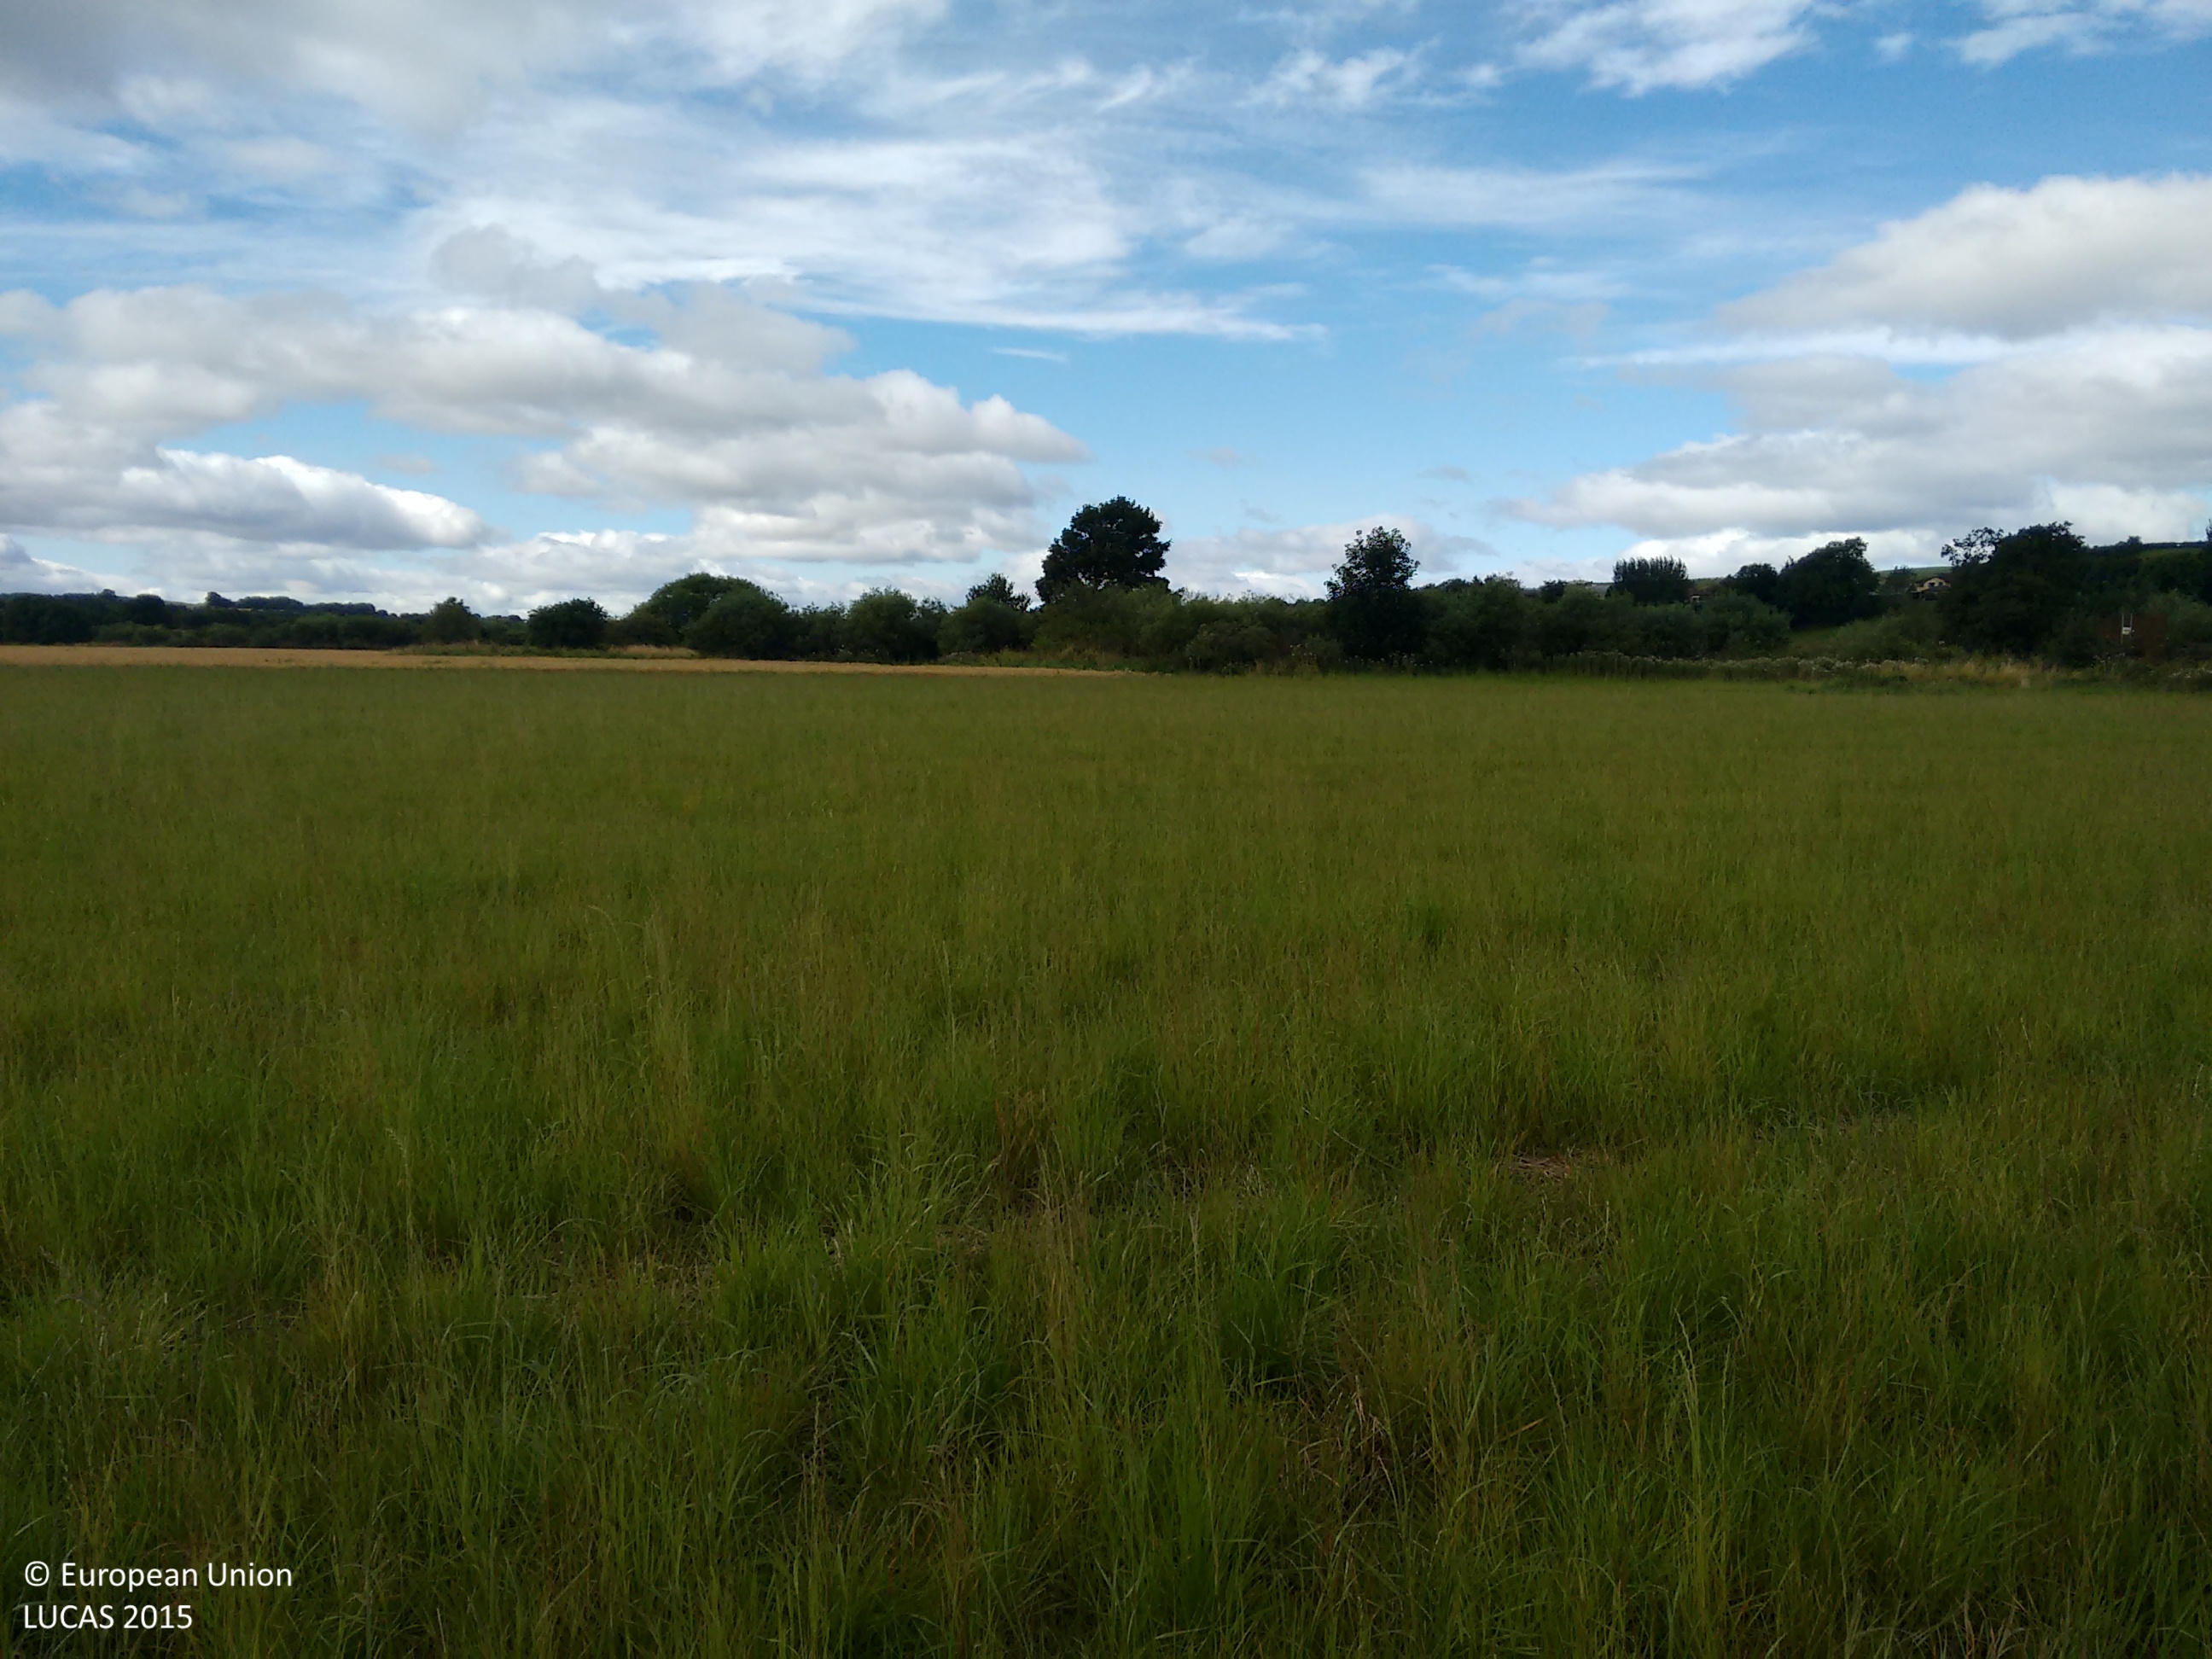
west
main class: Cropland
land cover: Temporary grasslands
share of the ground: > 75 %
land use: Agriculture (excluding fallow land and kitchen gardens)
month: September
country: GB
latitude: 55.9905
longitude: -3.9202
